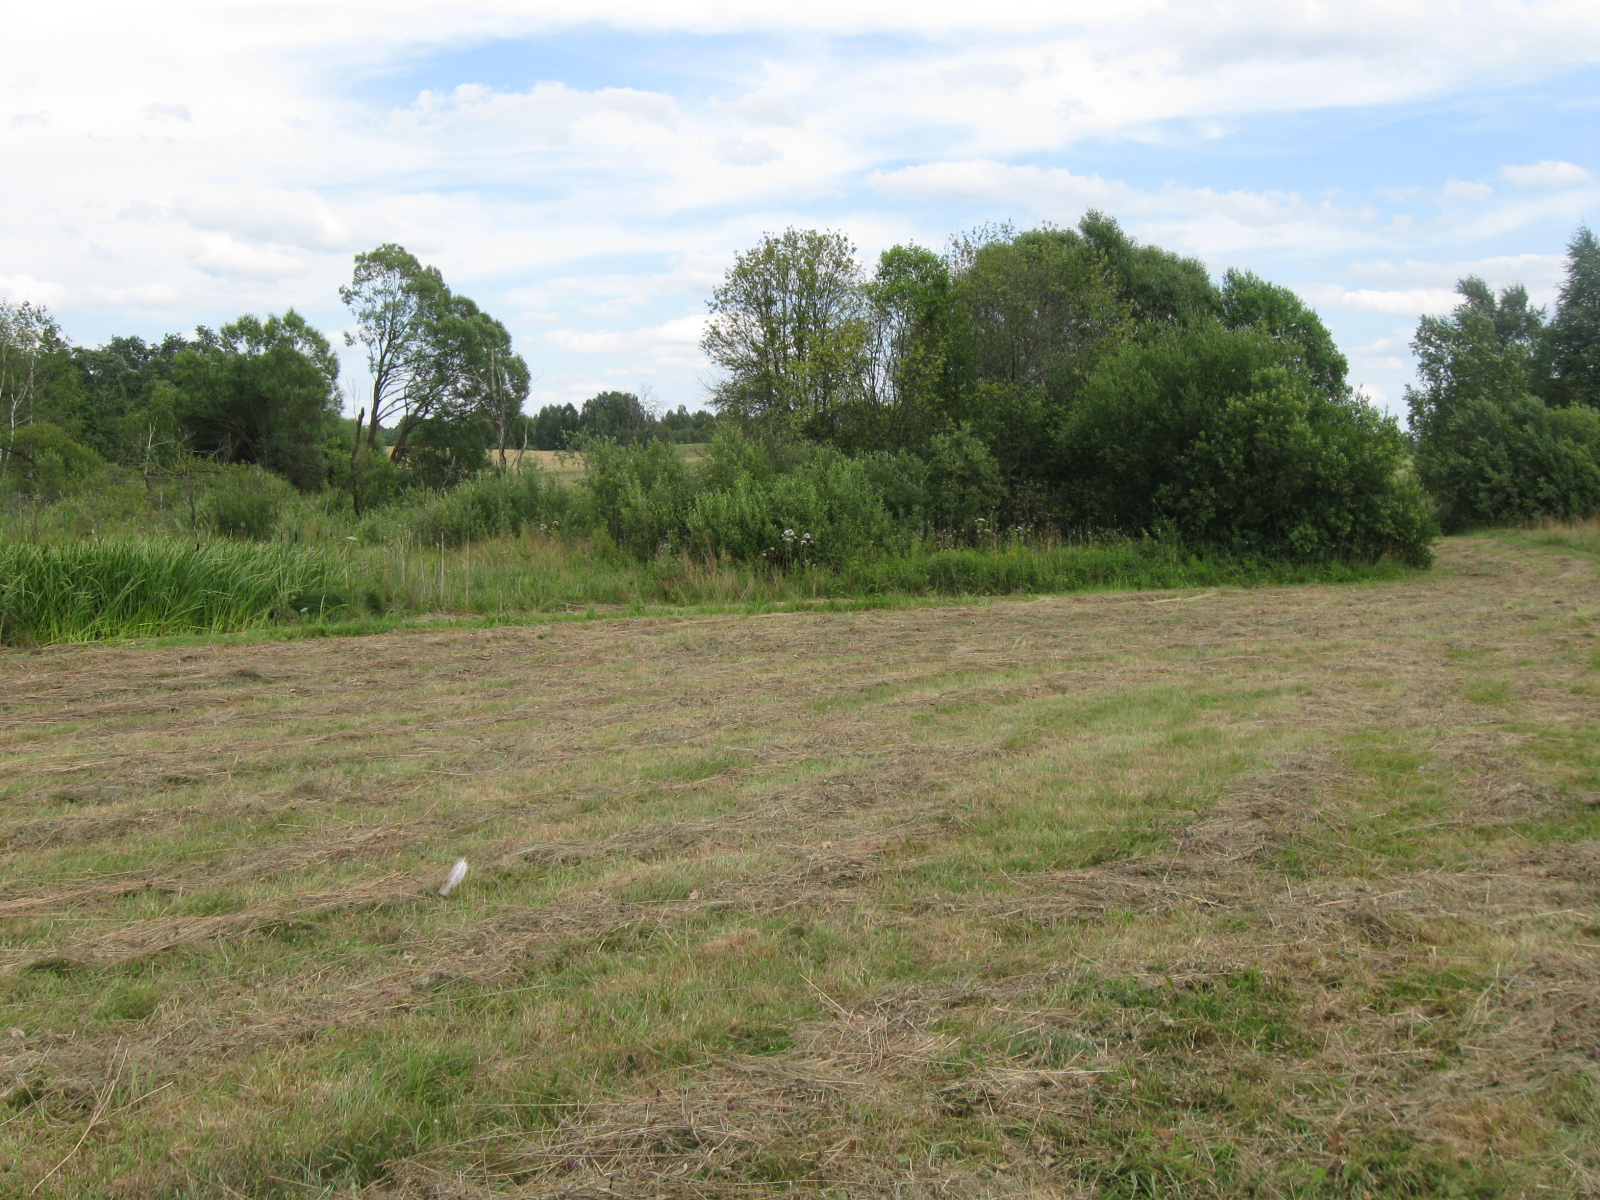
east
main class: Grassland
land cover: Grassland without tree/shrub cover
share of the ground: > 75 %
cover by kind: herbaceous plants 90 %, unconsolidated bare surface 10 %
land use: Agriculture (excluding fallow land and kitchen gardens)
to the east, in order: Grassland without tree/shrub cover; Spontaneously vegetated surfaces; Rivers and streams; Spontaneously vegetated surfaces; Broadleaved woodland; Rivers and streams; Broadleaved woodland; Spontaneously vegetated surfaces; Grassland without tree/shrub cover; Common wheat
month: July
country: LT
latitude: 54.5183
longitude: 24.3270
